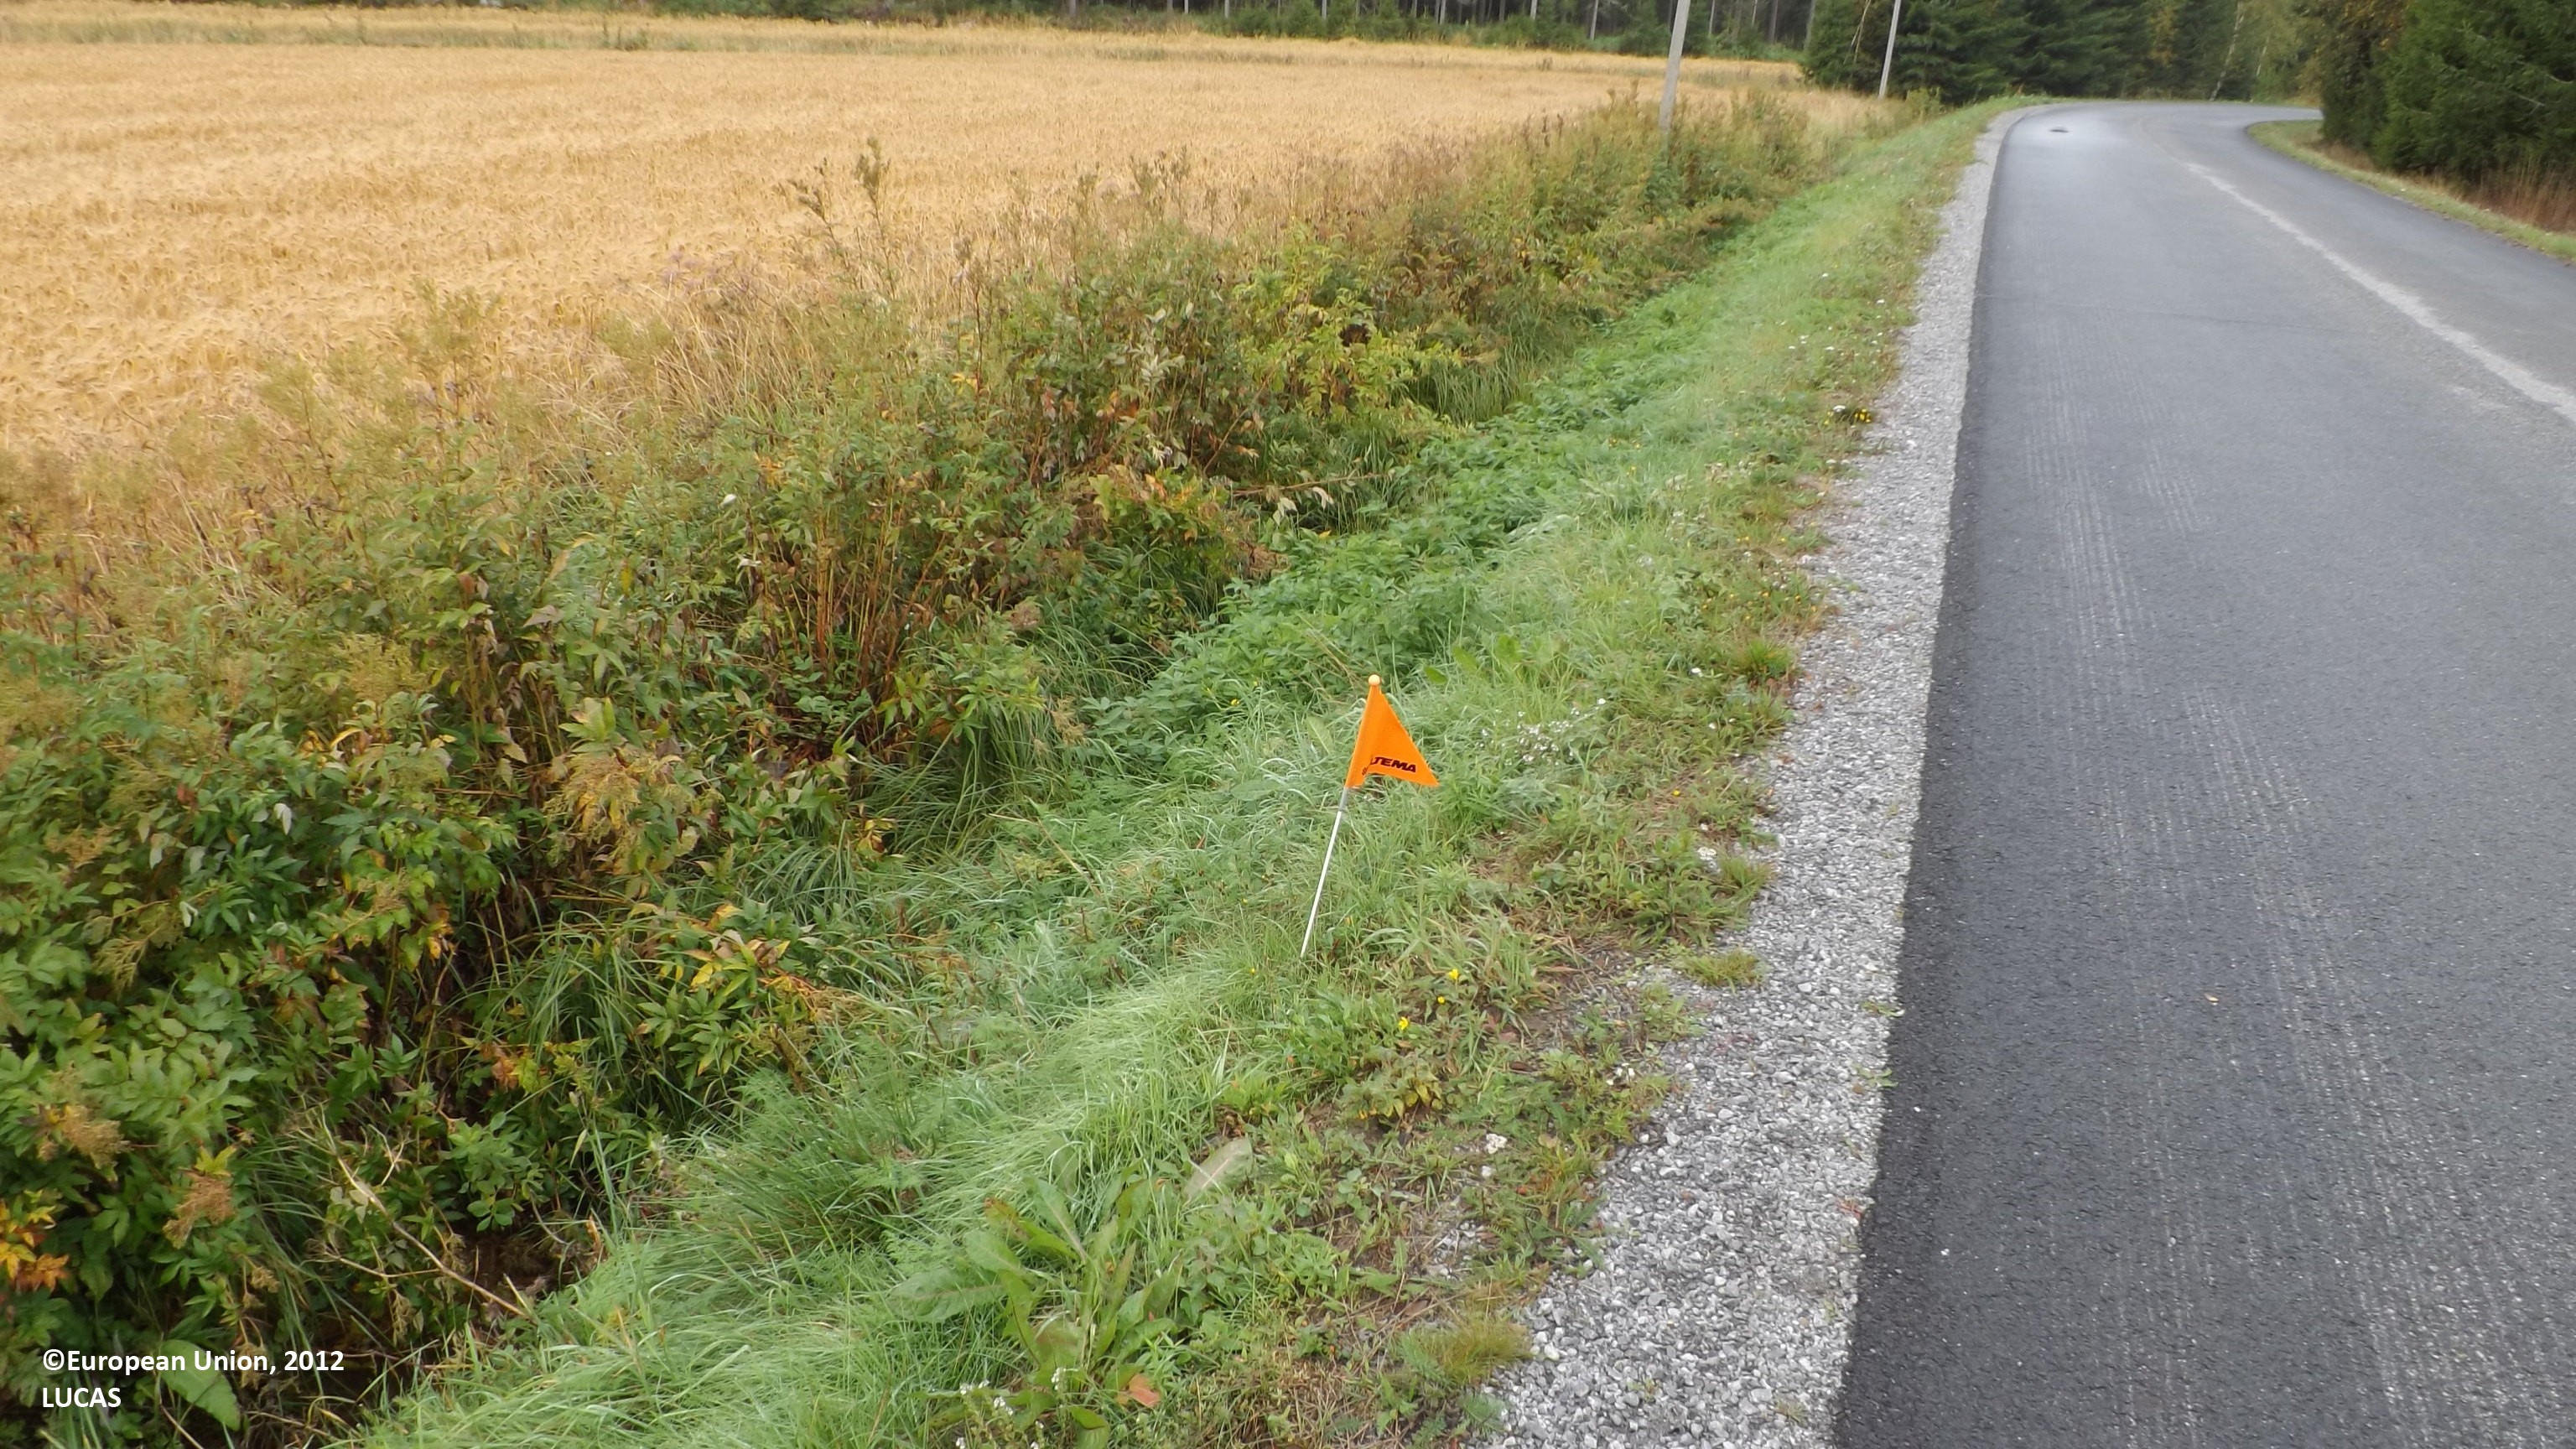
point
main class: Grassland
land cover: Spontaneously vegetated surfaces
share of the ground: > 75 %
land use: Road transport
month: August
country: FI
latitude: 63.8364
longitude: 23.2883
